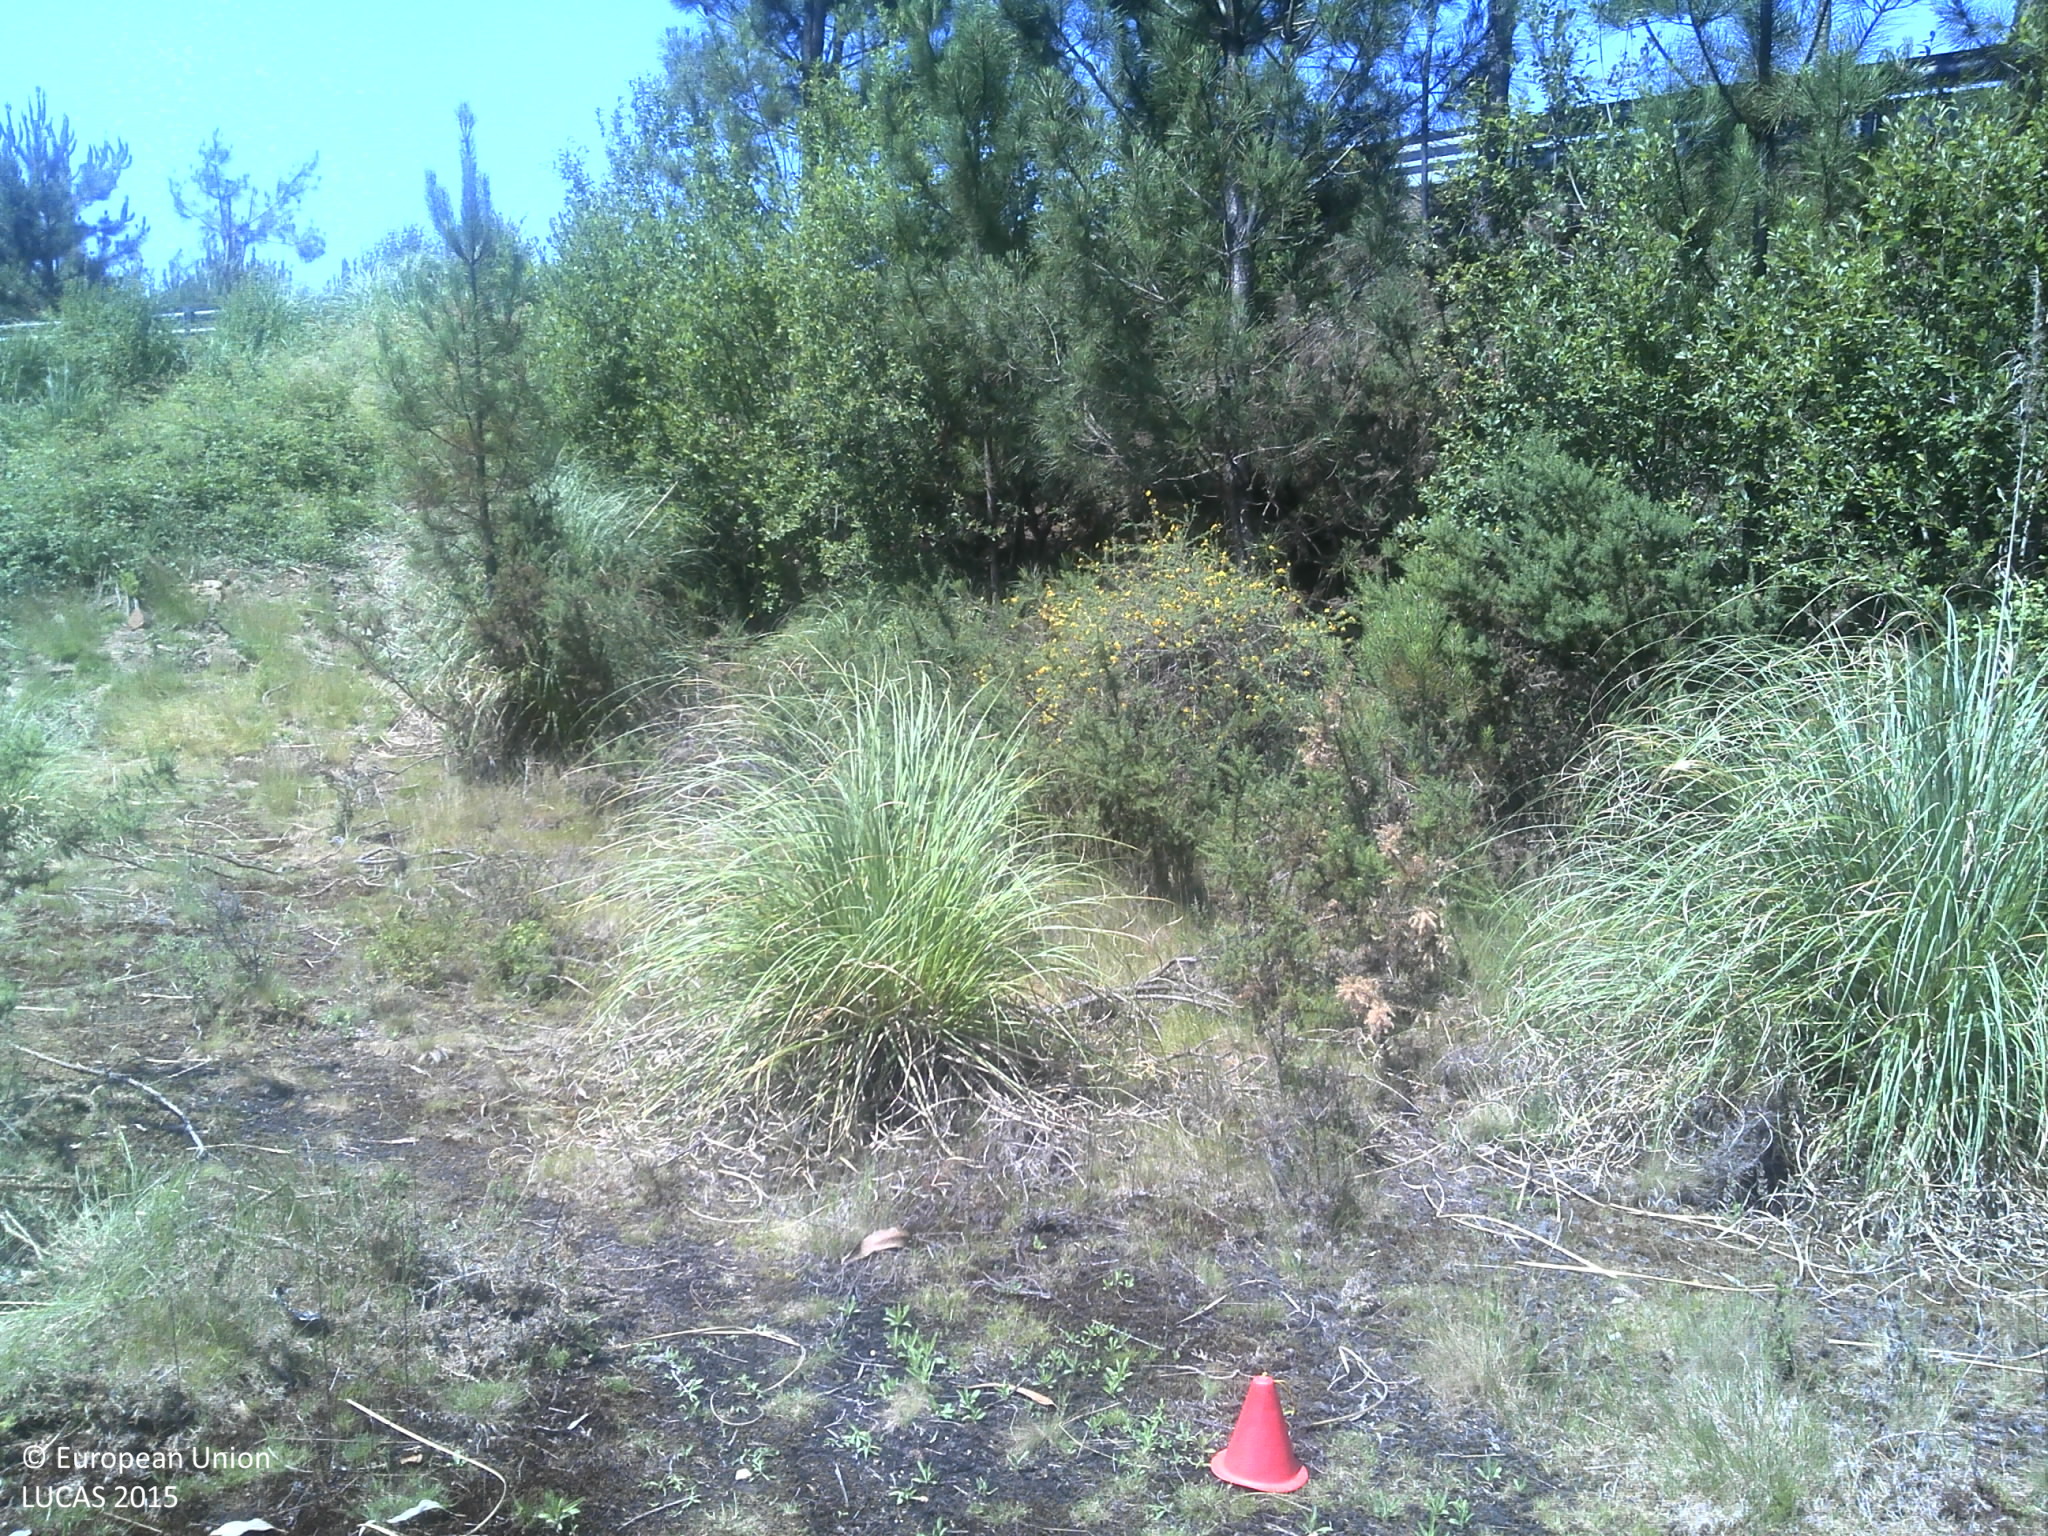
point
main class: Shrubland
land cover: Shrubland with sparse tree cover
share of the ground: > 75 %
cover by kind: shrubs 85 %, herbaceous plants 10 %, coniferous forest trees 5 %
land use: Semi-natural and natural areas not in use
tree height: > 5 m
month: June
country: PT
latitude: 41.5272
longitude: -8.5782
